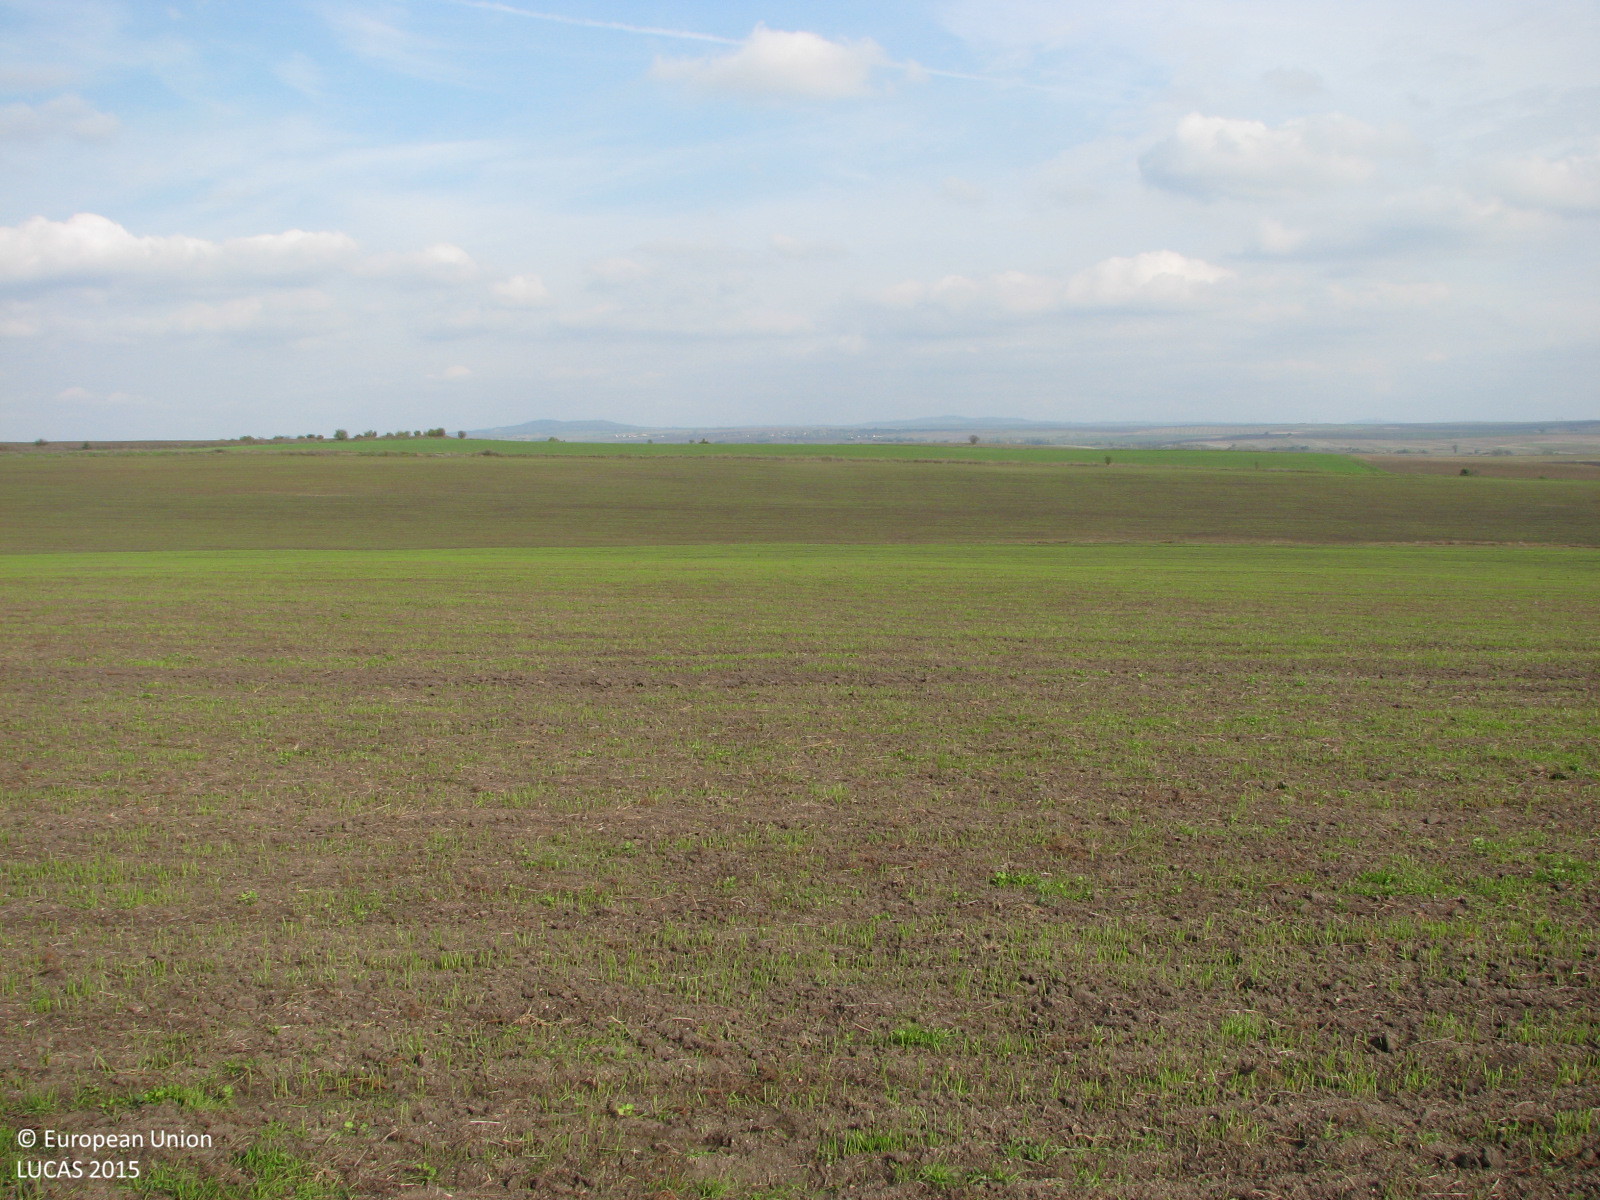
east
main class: Cropland
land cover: Common wheat
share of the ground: 10 - 25 %
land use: Agriculture (excluding fallow land and kitchen gardens)
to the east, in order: Common wheat; Grass margins; Common wheat
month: October
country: BG
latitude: 42.2248
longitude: 26.6295
